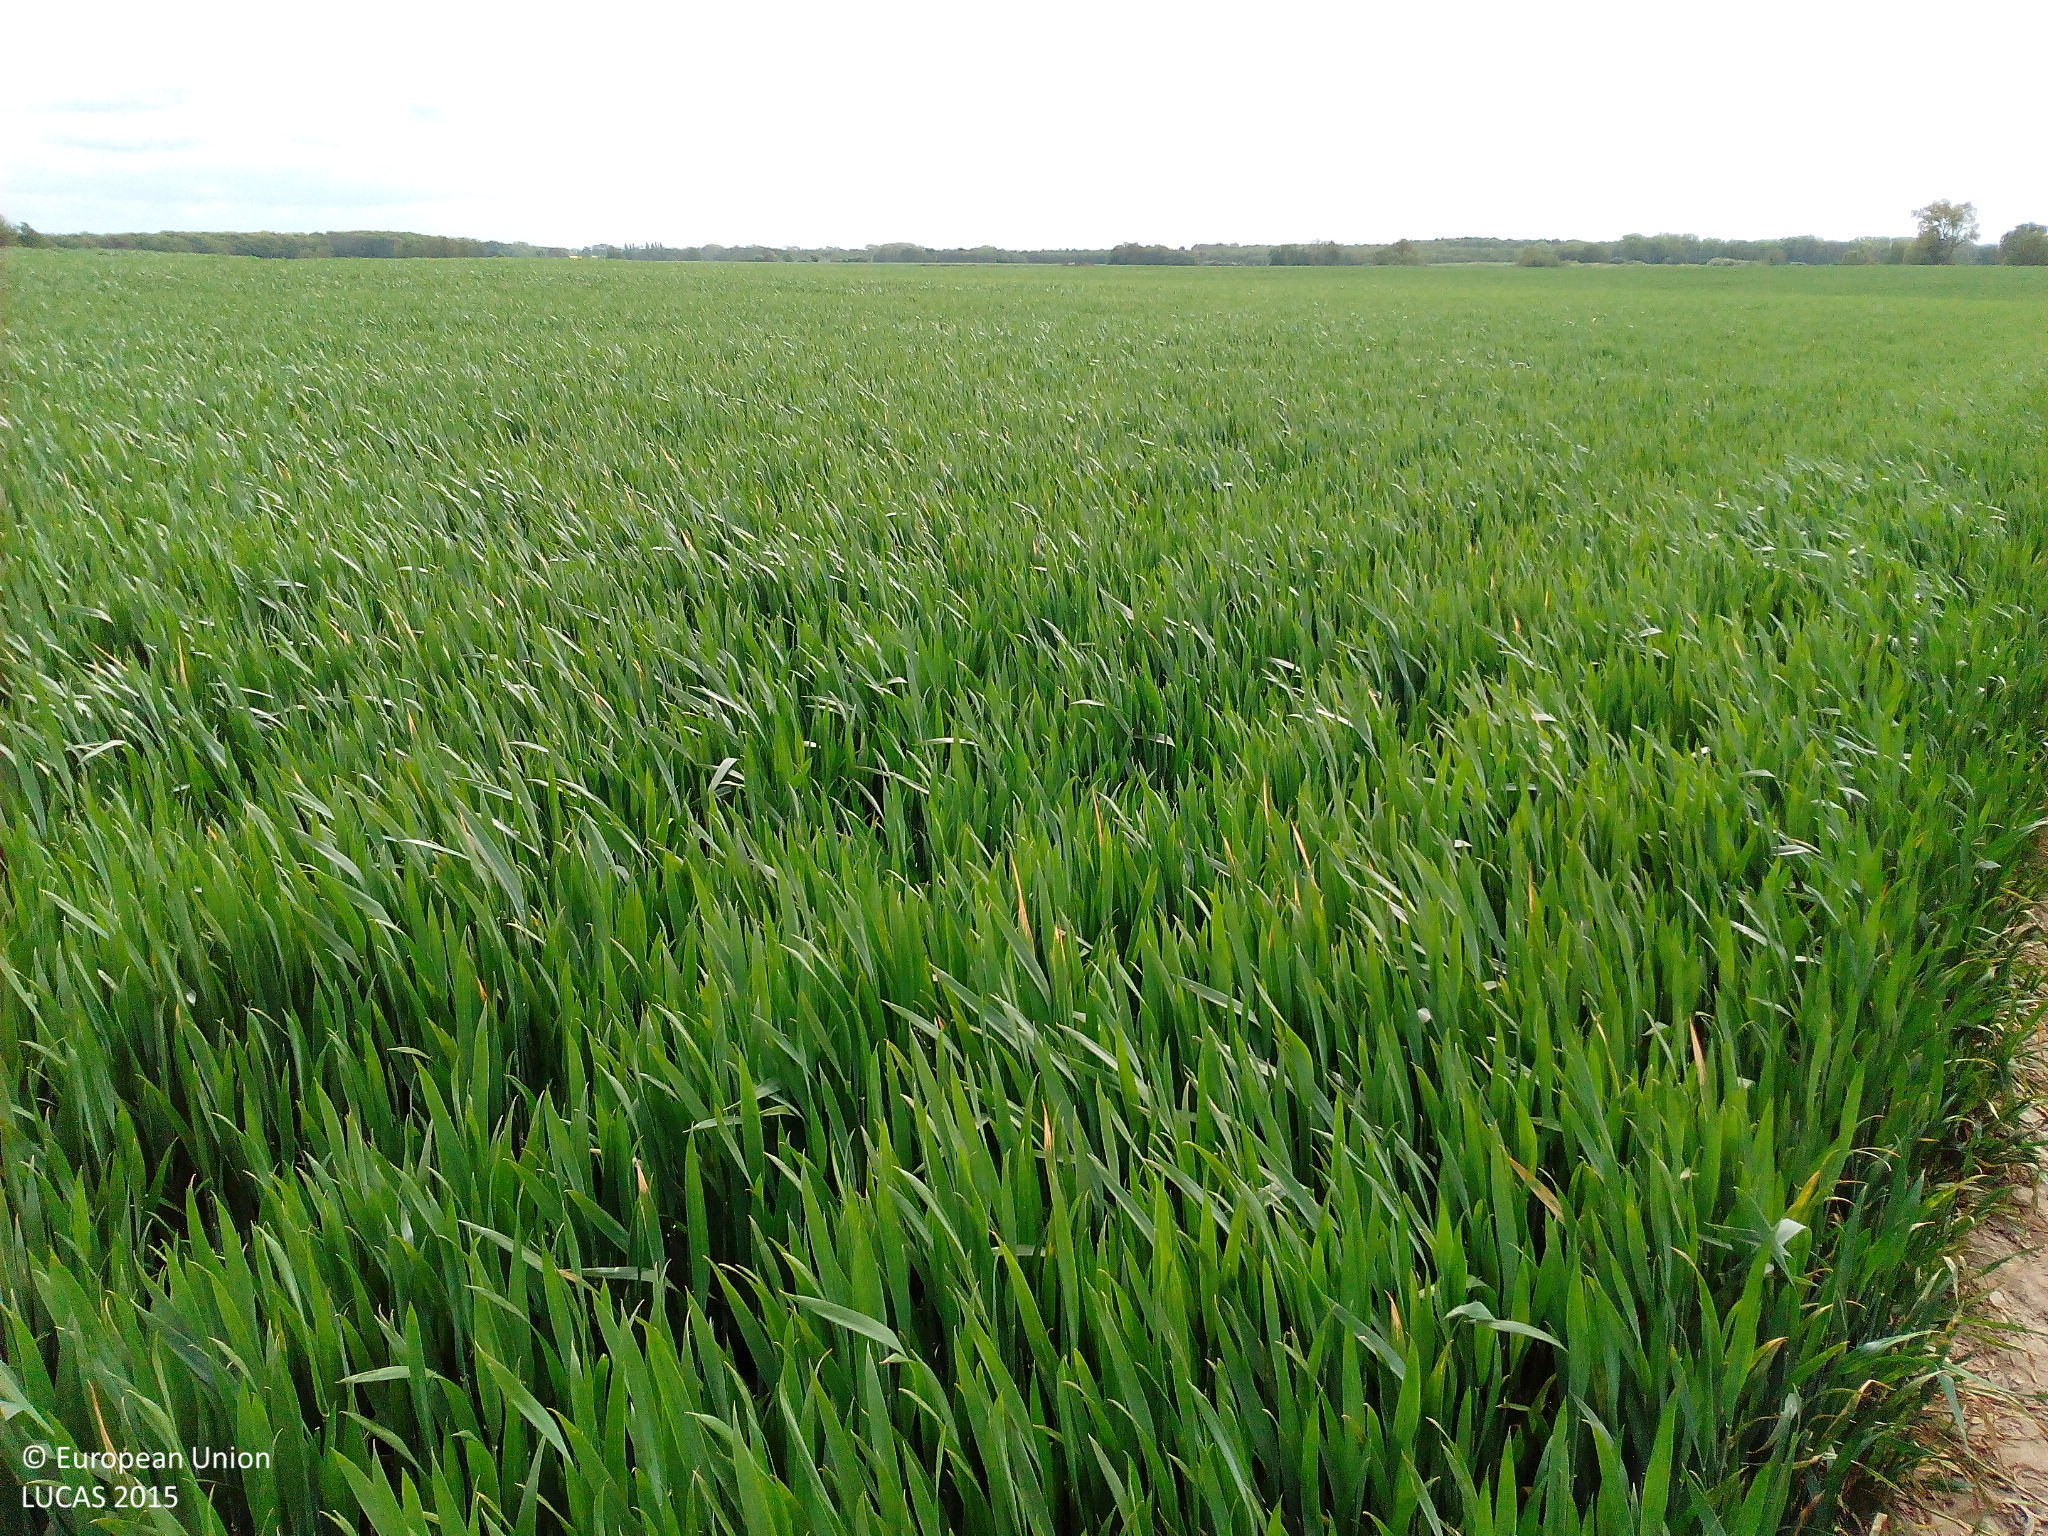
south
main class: Cropland
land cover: Rye
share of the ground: > 75 %
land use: Agriculture (excluding fallow land and kitchen gardens)
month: May
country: DE
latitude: 54.5257
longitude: 13.3210
